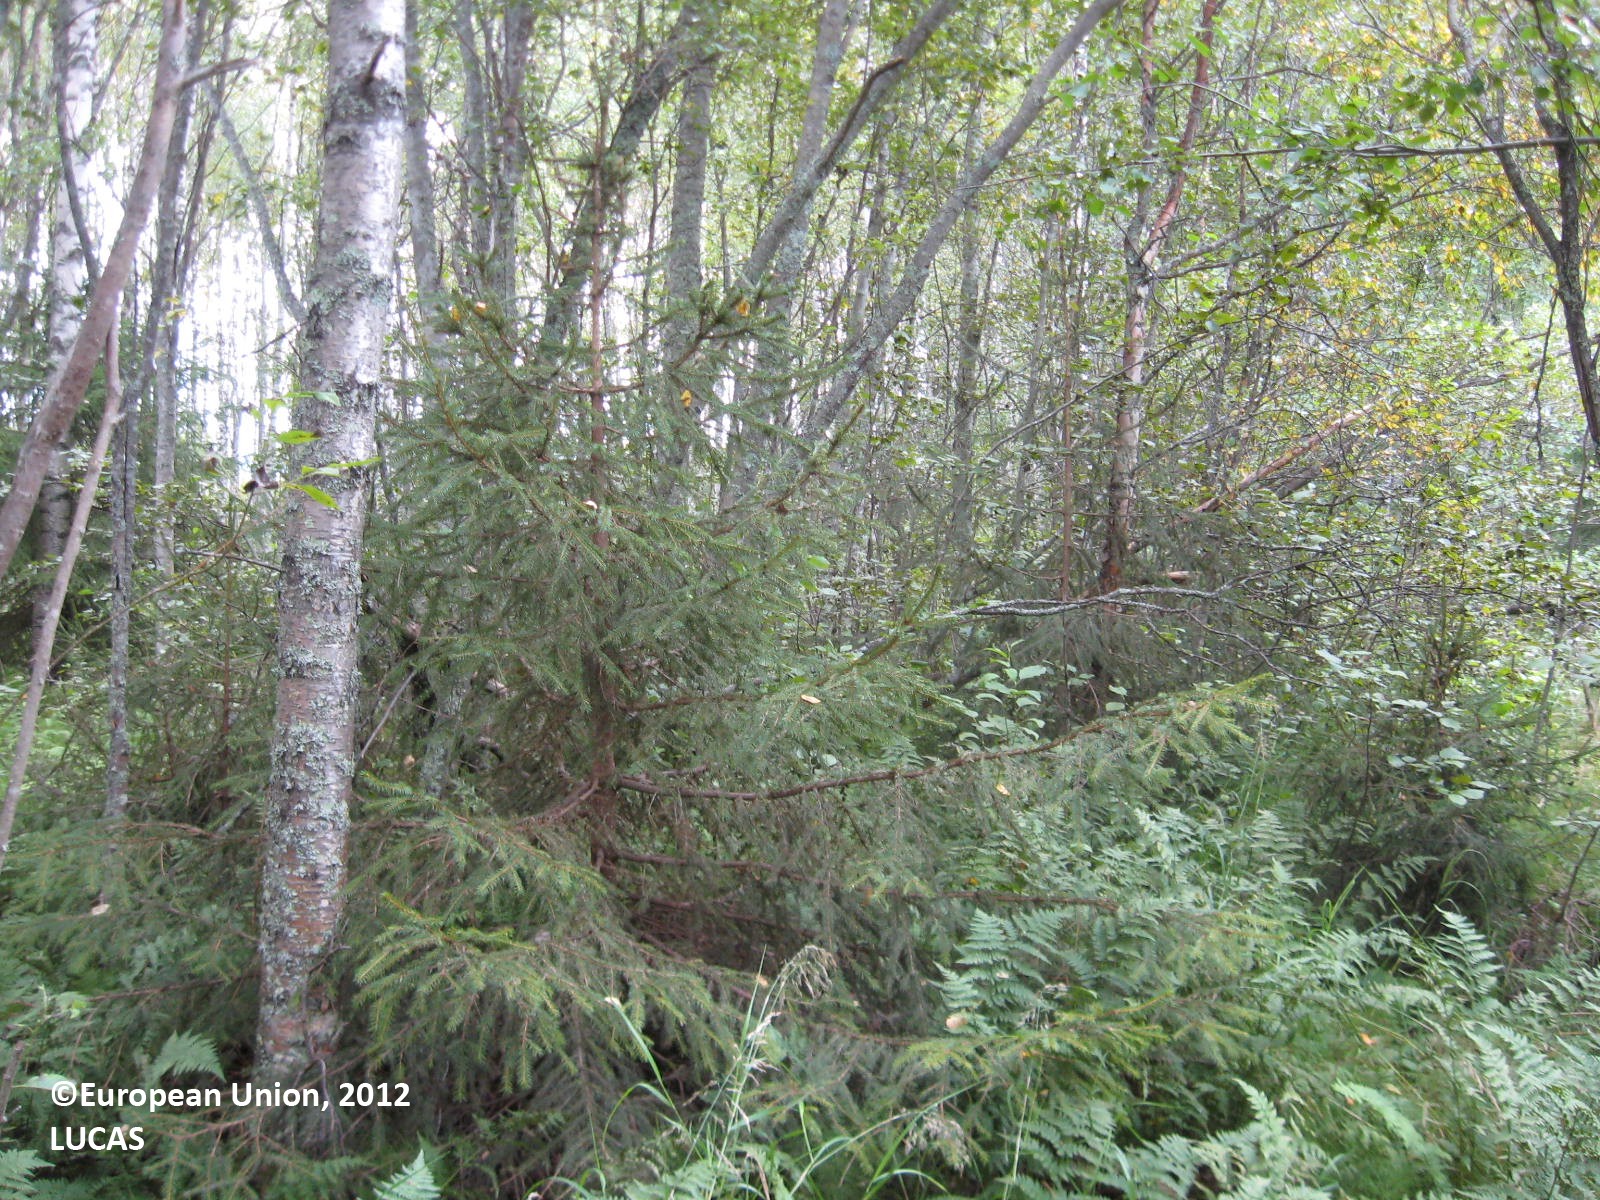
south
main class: Woodland
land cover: Broadleaved woodland
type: boreal forest
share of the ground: 50 - 75 %
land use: Forestry
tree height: > 5 m
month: August
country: FI
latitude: 63.4168
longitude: 29.6010
